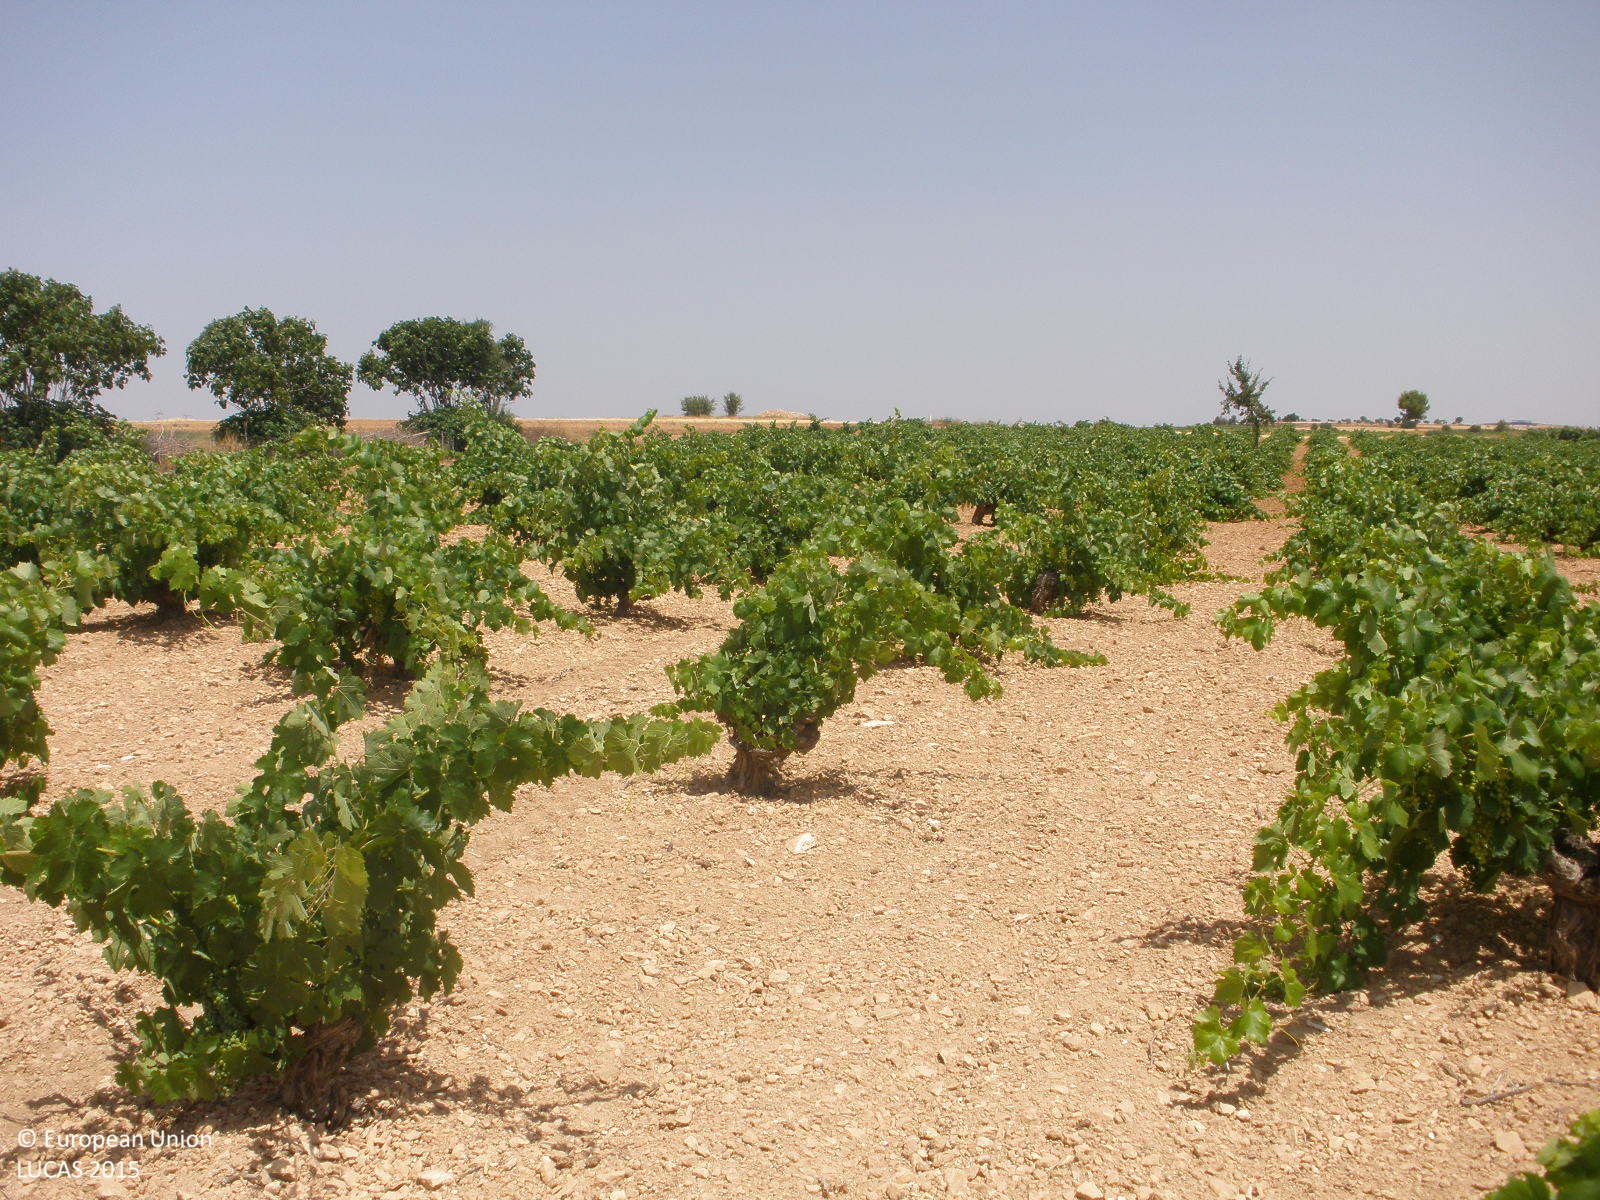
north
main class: Cropland
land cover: Vineyards
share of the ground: 50 - 75 %
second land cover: Other bare soil
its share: > 75 %
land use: Agriculture (excluding fallow land and kitchen gardens)
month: July
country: ES
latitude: 39.9640
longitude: -3.1485
